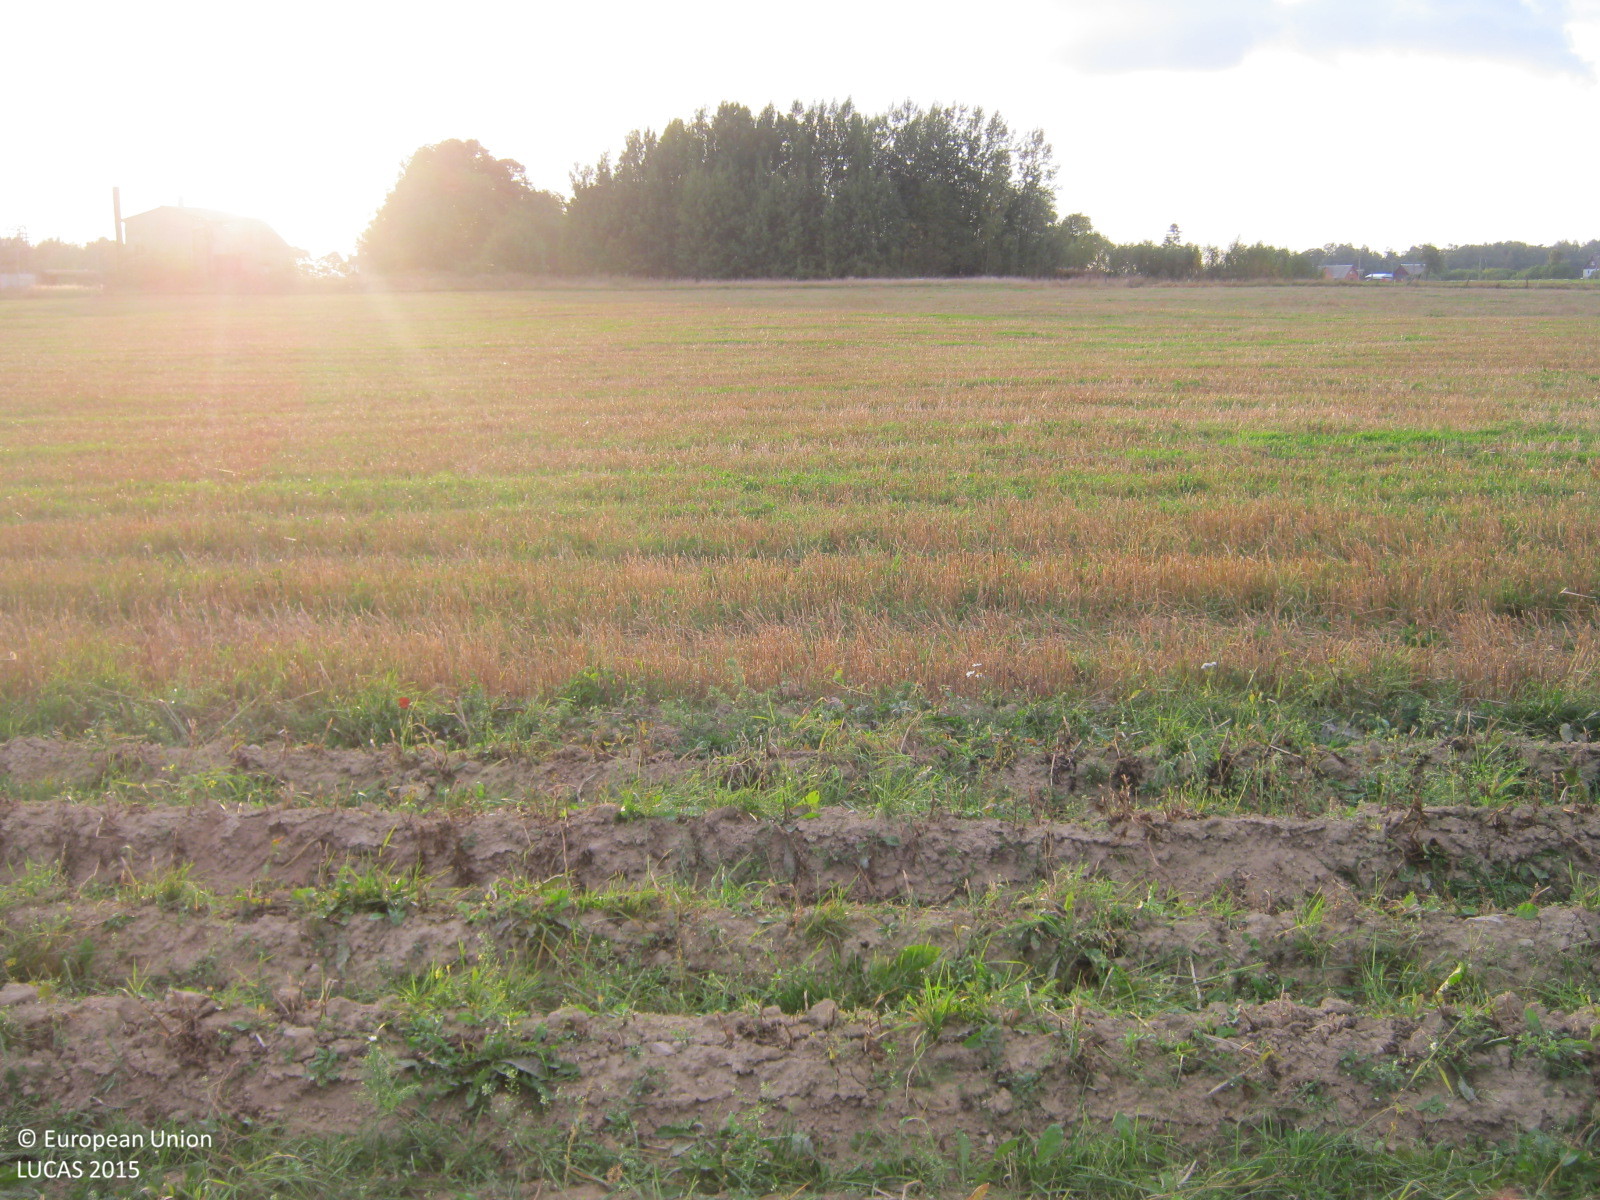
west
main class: Grassland
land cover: Grassland without tree/shrub cover
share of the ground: > 75 %
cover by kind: herbaceous plants 95 %
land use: Agriculture (excluding fallow land and kitchen gardens)
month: September
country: LV
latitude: 57.3806
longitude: 24.7510
